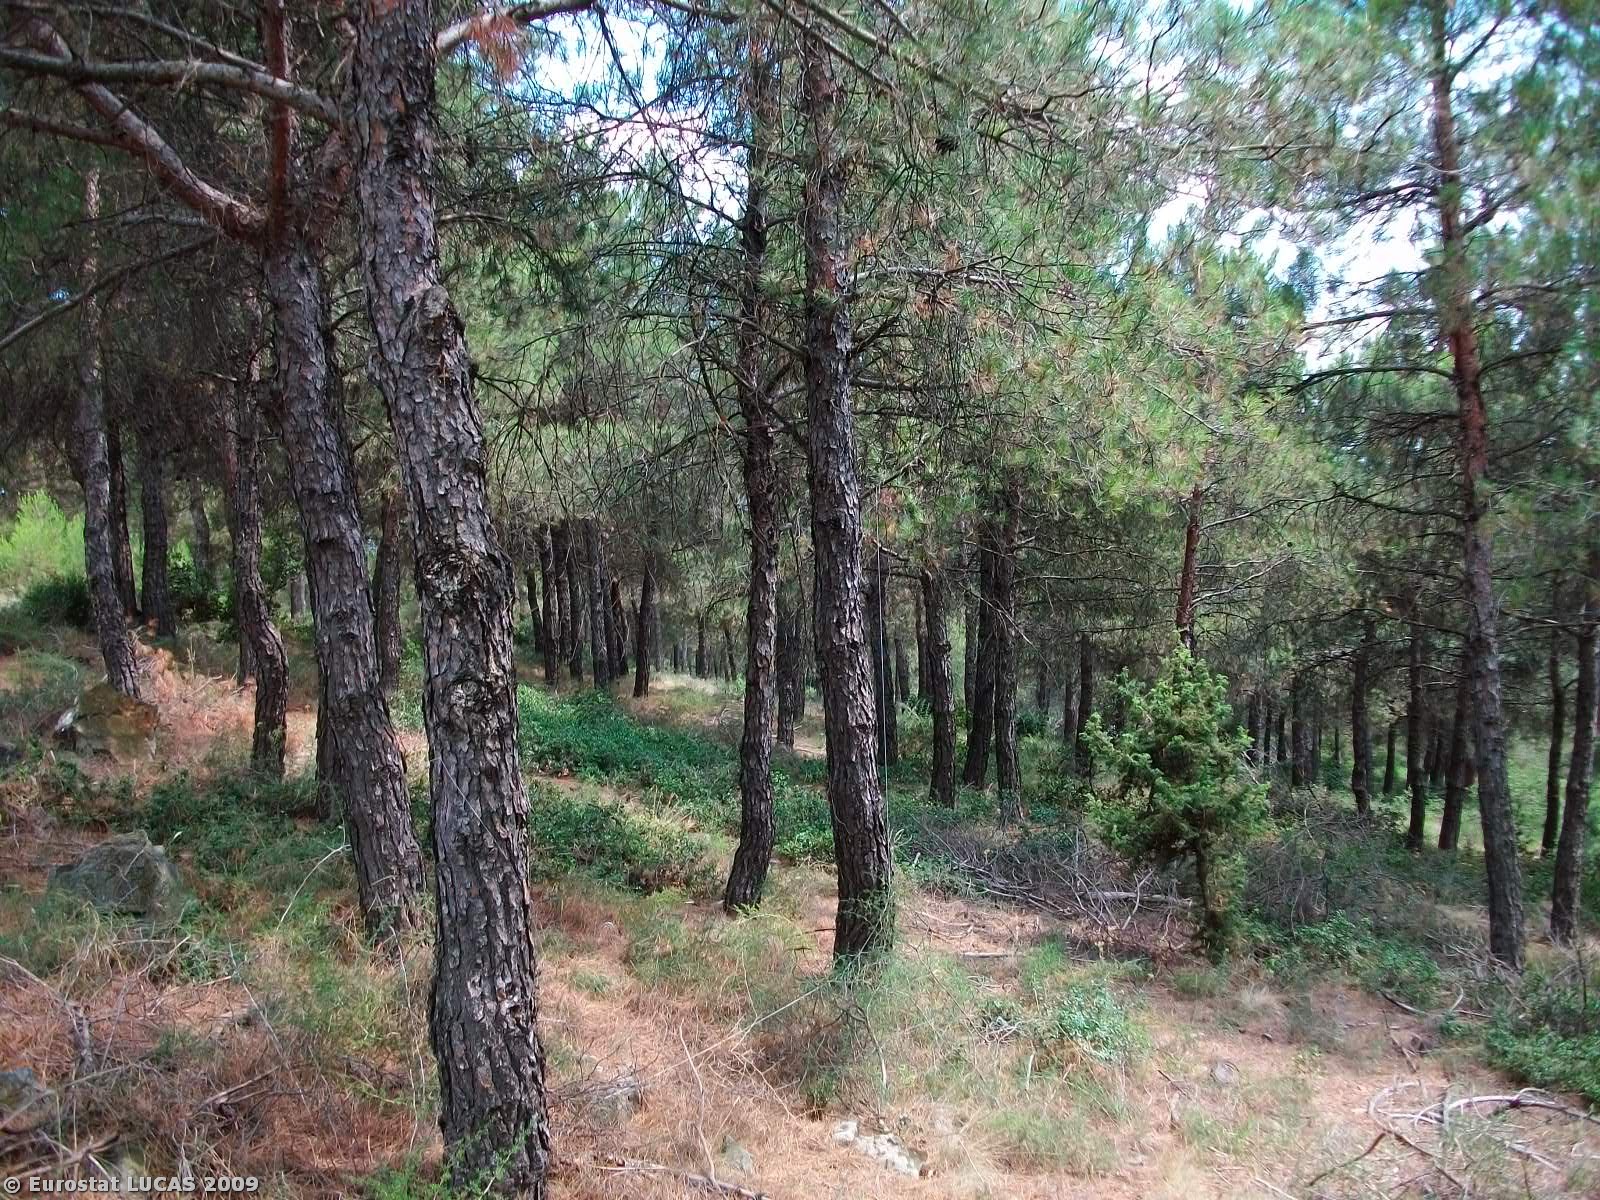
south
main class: Woodland
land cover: Coniferous woodland
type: coniferous forest of the mediterranean region
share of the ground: > 75 %
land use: Forestry
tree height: > 5 m
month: June
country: GR
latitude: 40.6451
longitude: 22.9800
